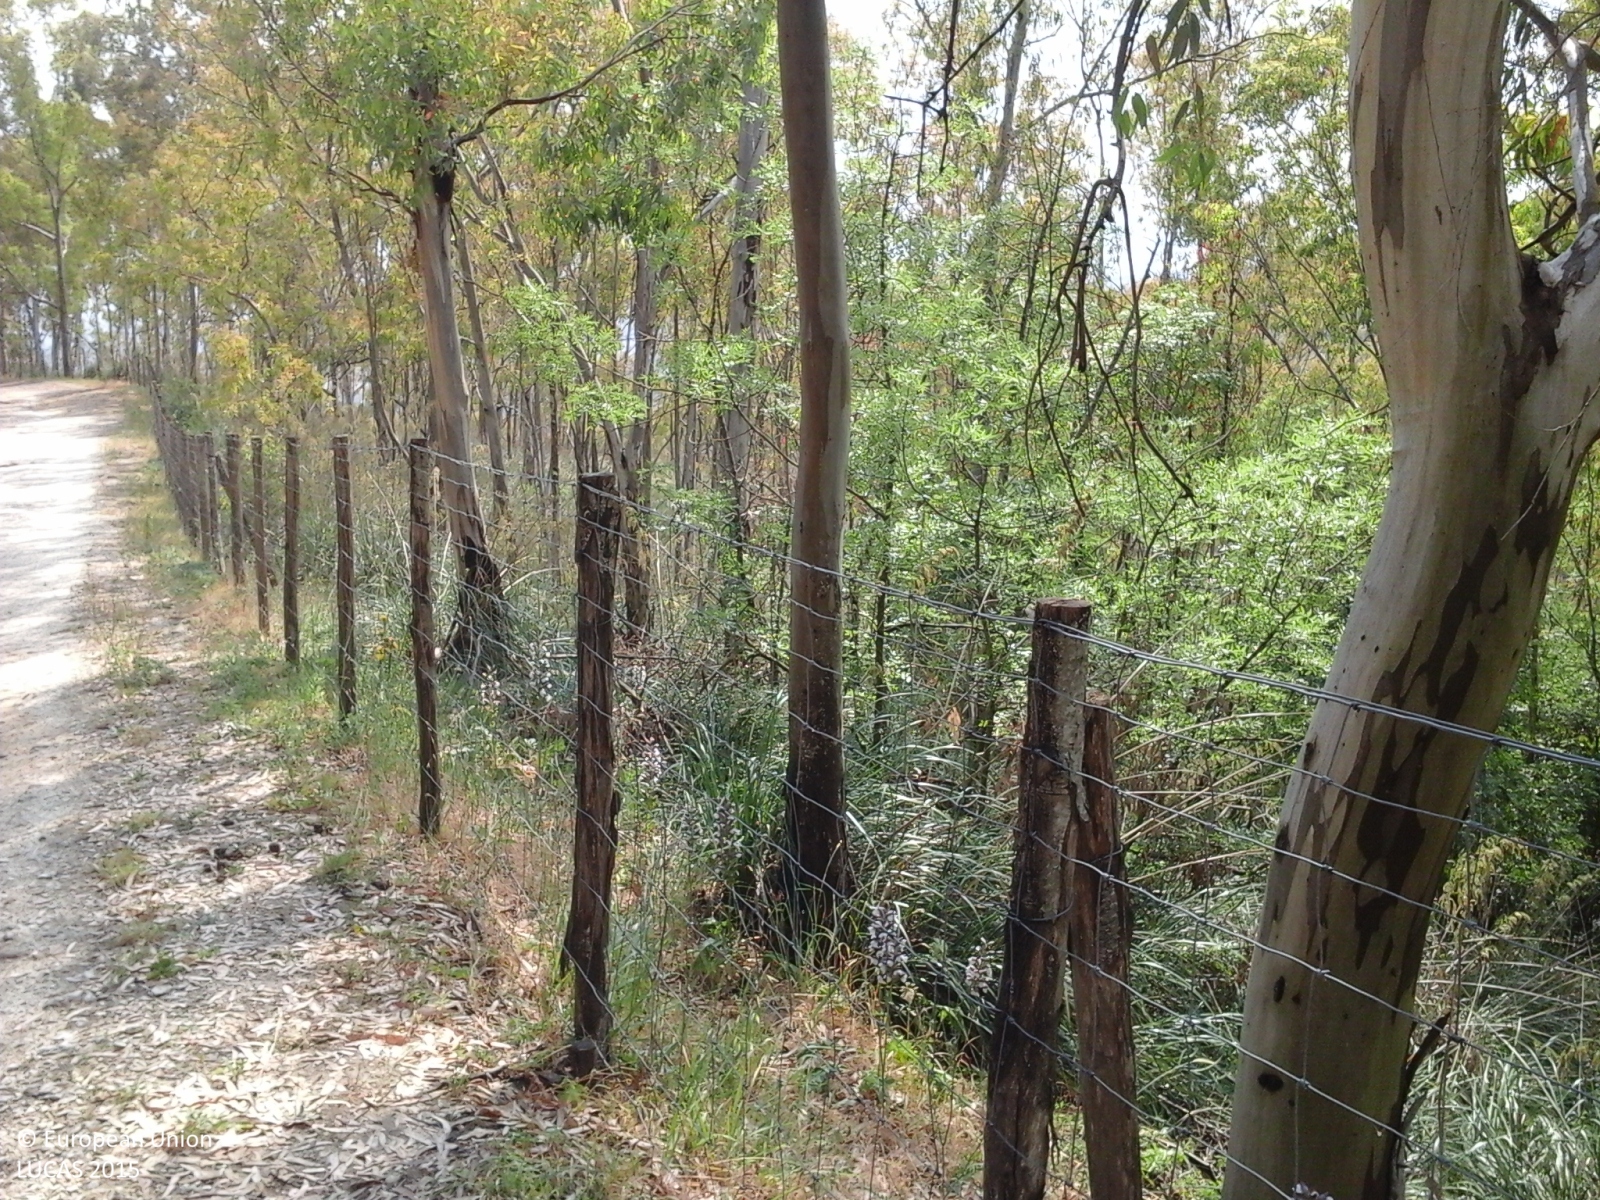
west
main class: Woodland
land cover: Broadleaved woodland
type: thermophilous deciduous forest
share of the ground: > 75 %
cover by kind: broadleaved forest trees 70 %, shrubs 20 %, herbaceous plants 10 %
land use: Forestry
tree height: > 5 m
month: June
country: IT
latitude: 37.2629
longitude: 14.4202
